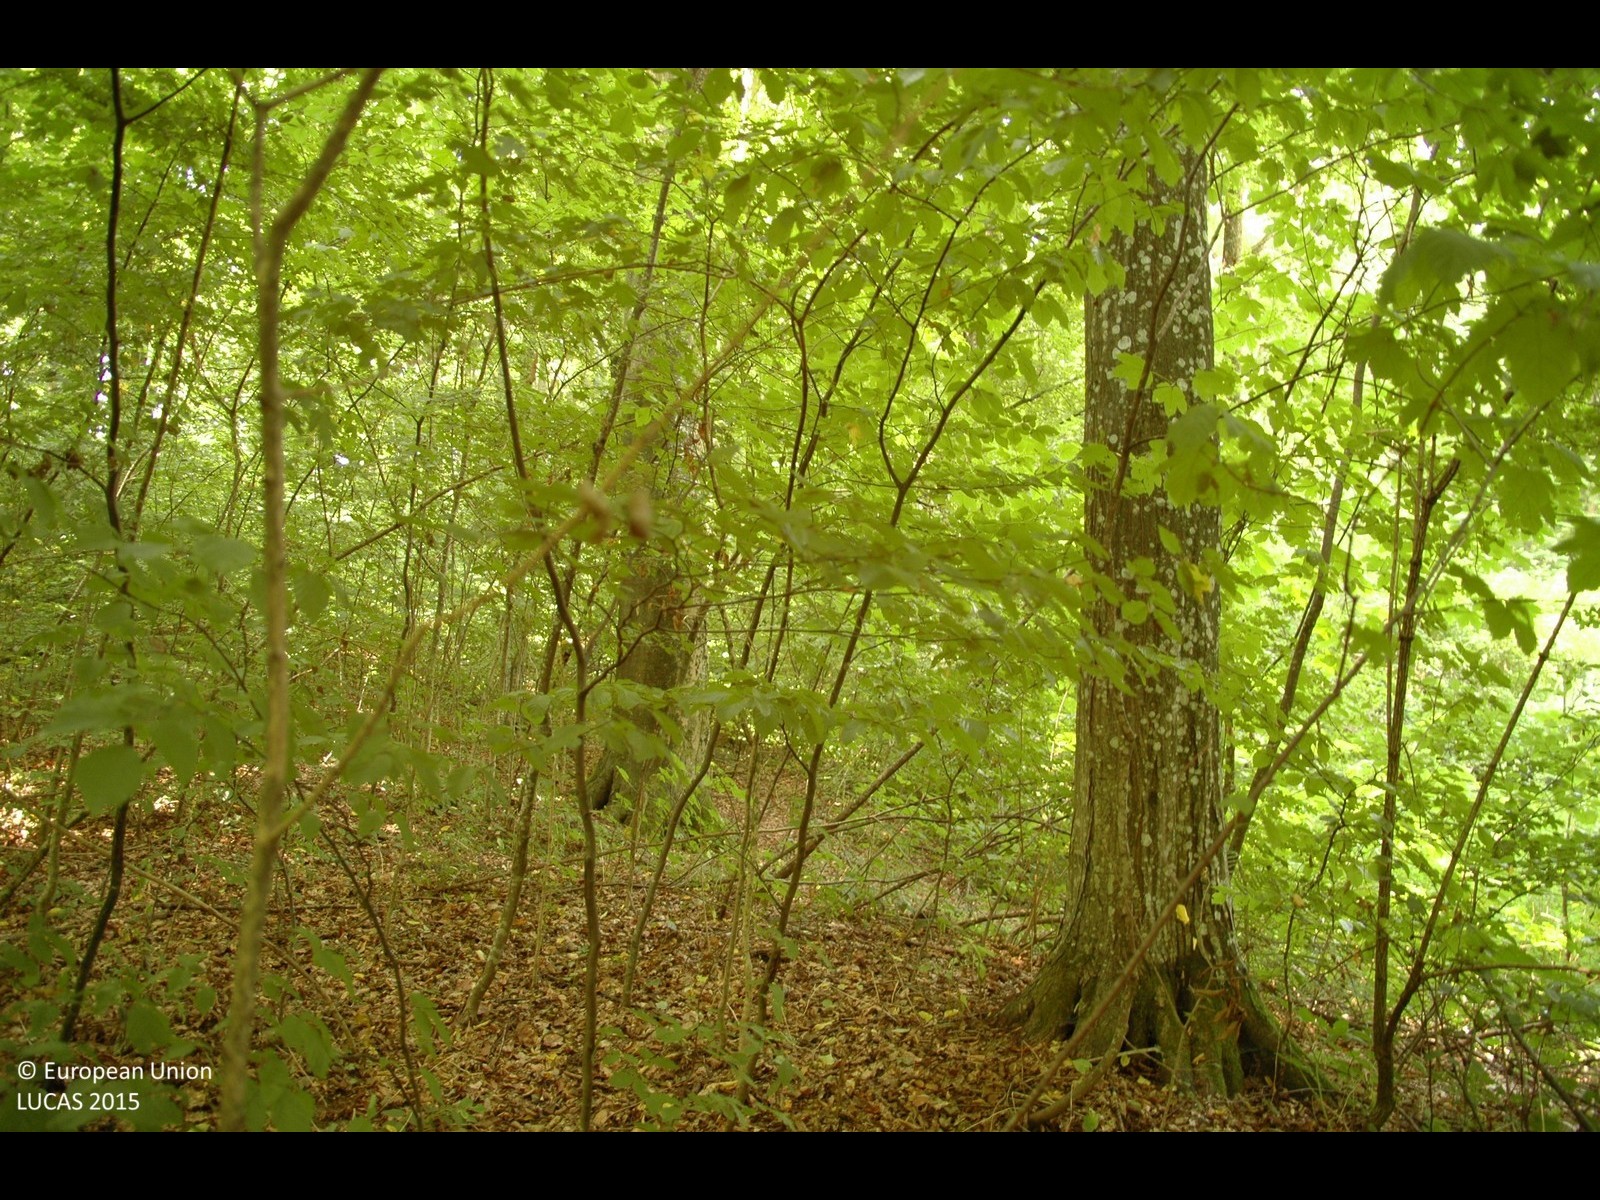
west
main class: Woodland
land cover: Broadleaved woodland
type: mesophytic deciduous forest
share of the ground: > 75 %
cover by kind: broadleaved forest trees 100 %
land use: Forestry
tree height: > 5 m
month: July
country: HR
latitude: 46.1626
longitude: 16.6442
